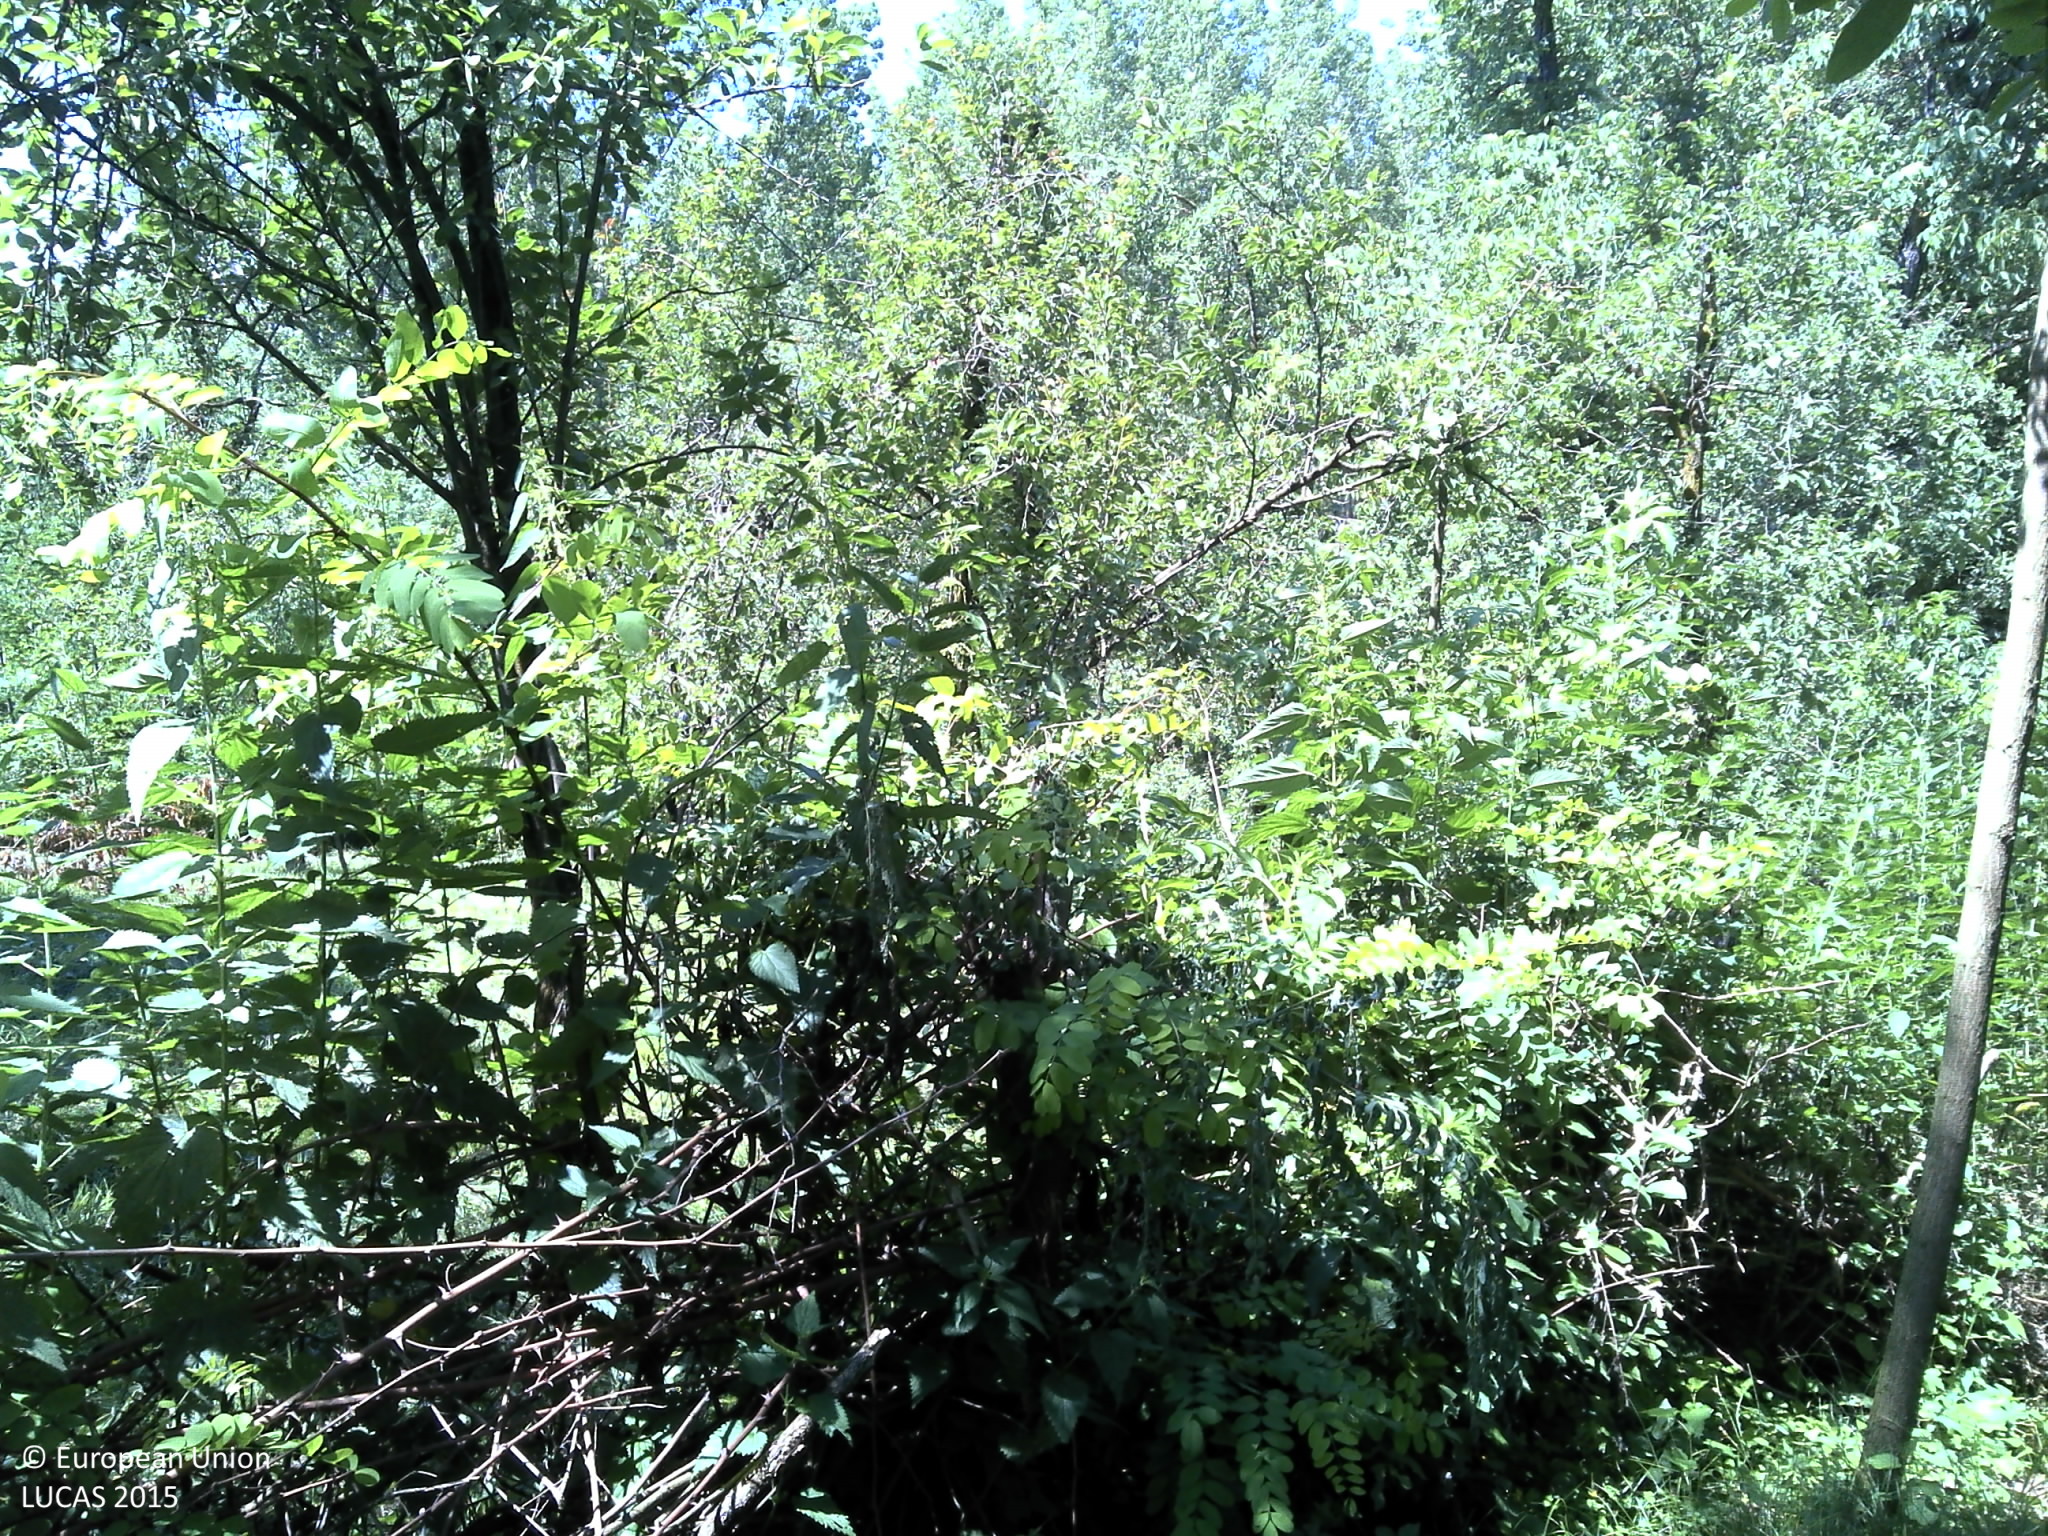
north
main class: Grassland
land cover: Grassland with sparse tree/shrub cover
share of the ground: > 75 %
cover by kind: herbaceous plants 95 %, broadleaved forest trees 5 %
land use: Semi-natural and natural areas not in use
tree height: < 5 m
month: June
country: HR
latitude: 45.7429
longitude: 18.2447
